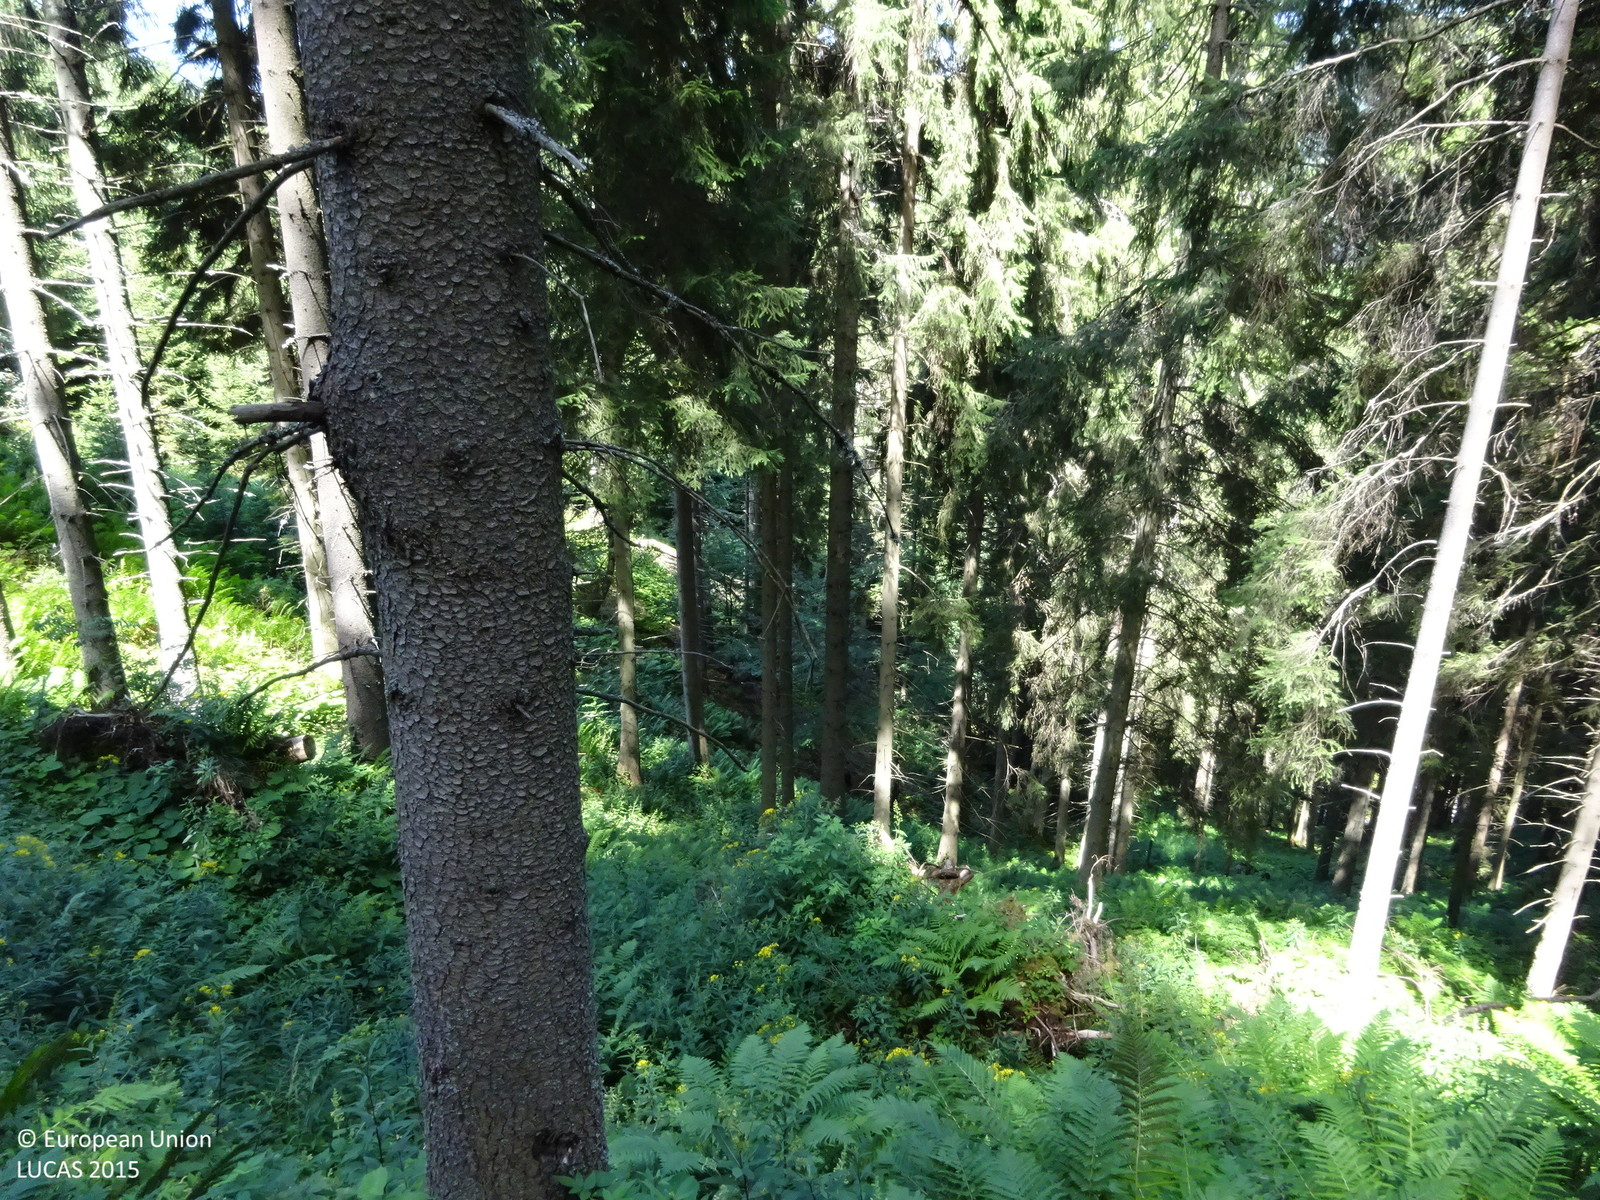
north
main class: Woodland
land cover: Spruce dominated coniferous woodland
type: alpine coniferous forest
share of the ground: > 75 %
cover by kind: coniferous forest trees 85 %, herbaceous plants 10 %, shrubs 5 %
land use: Forestry
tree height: > 5 m
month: August
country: AT
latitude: 47.3636
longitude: 15.5222
